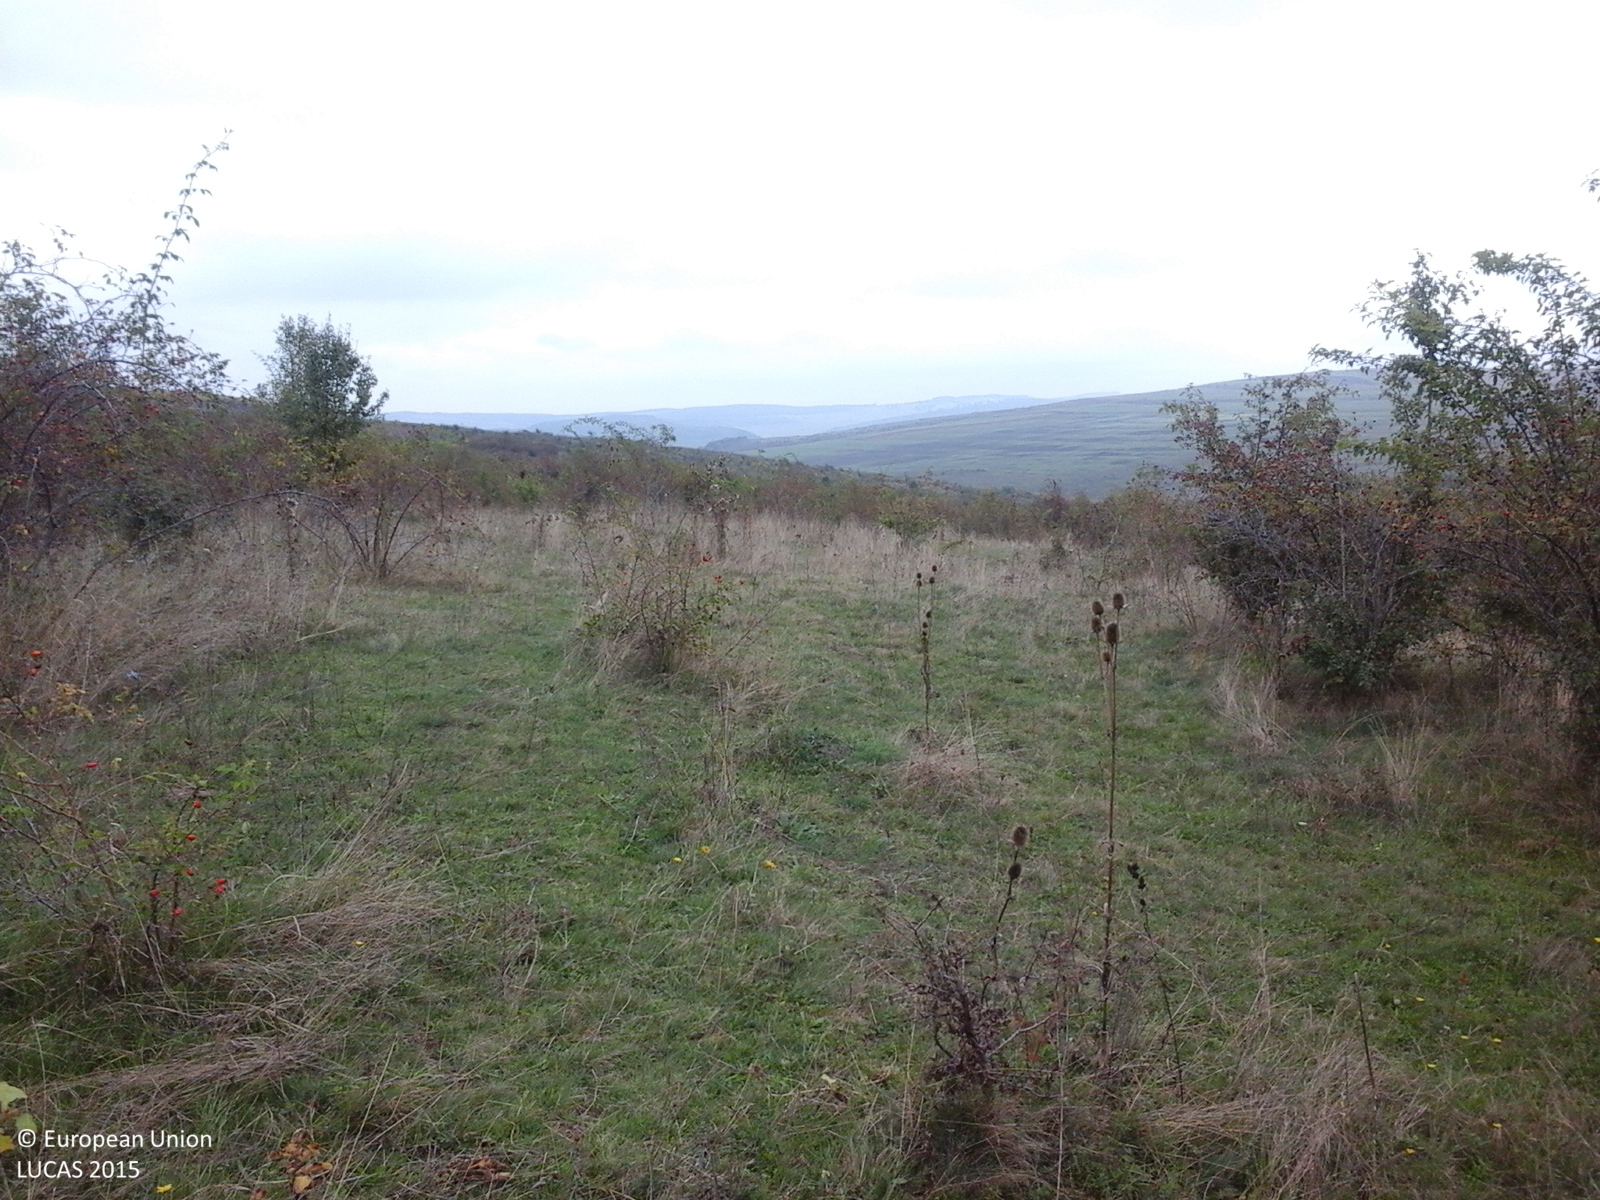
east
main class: Grassland
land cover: Grassland with sparse tree/shrub cover
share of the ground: > 75 %
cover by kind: herbaceous plants 95 %, broadleaved forest trees 5 %
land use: Semi-natural and natural areas not in use
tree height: < 5 m
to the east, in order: Grassland with sparse tree/shrub cover; Shrubland without tree cover
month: October
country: RO
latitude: 46.3716
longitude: 24.0252
